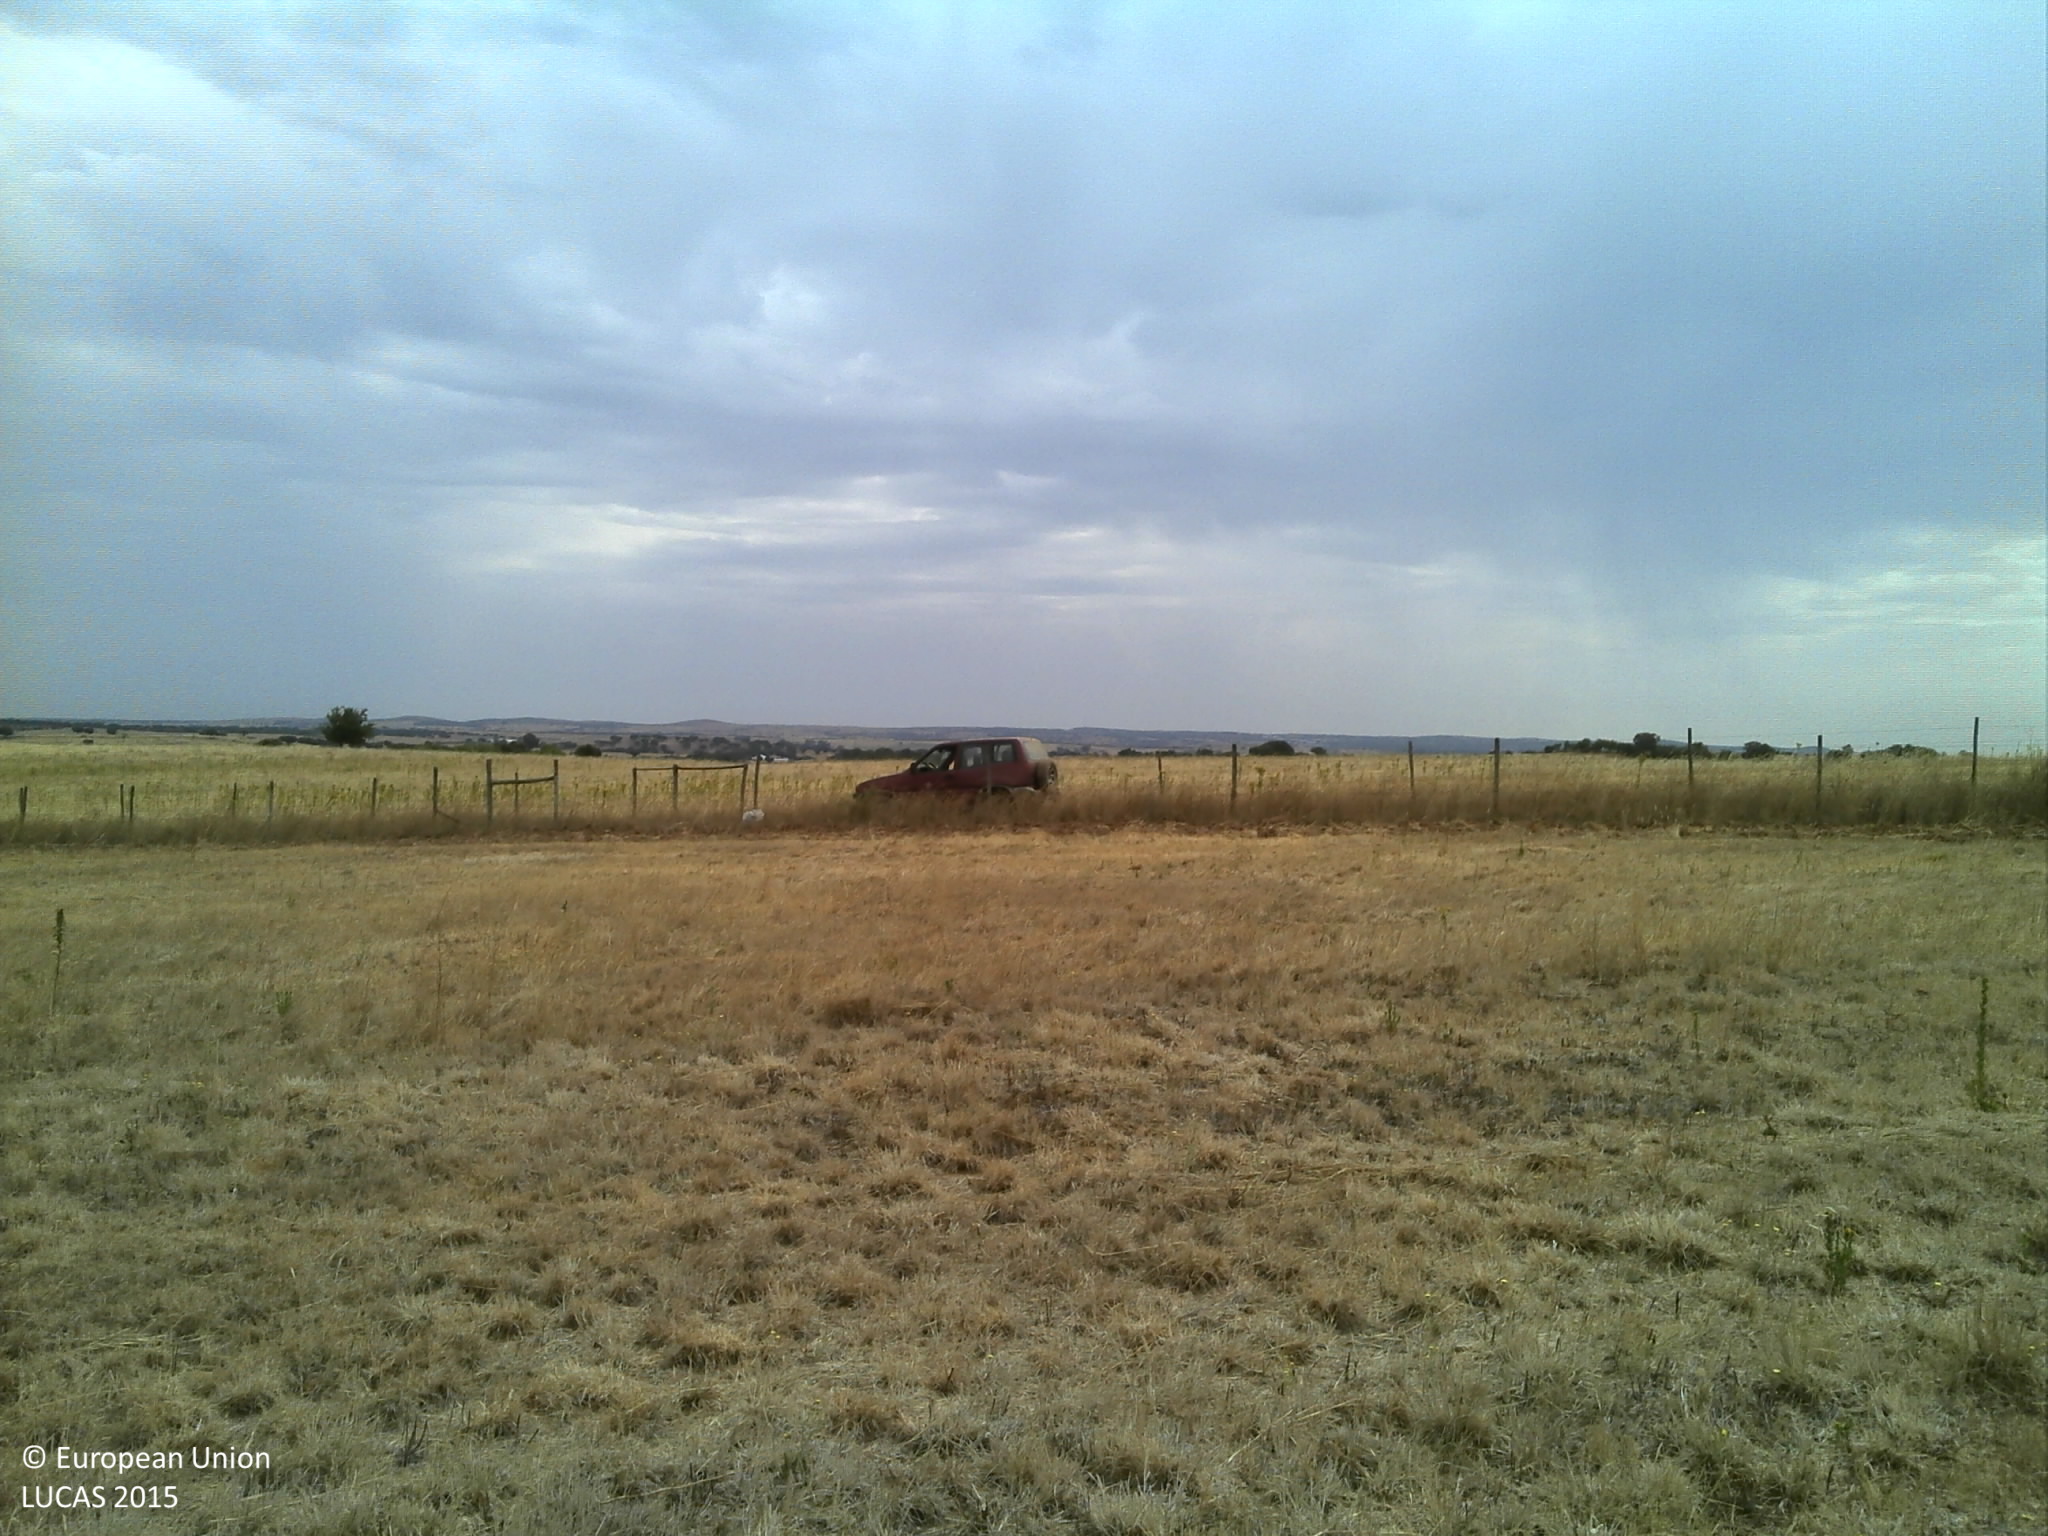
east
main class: Grassland
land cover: Grassland without tree/shrub cover
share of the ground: 25 - 50 %
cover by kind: unconsolidated bare surface 60 %, herbaceous plants 40 %
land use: Agriculture (excluding fallow land and kitchen gardens)
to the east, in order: Grassland without tree/shrub cover; Other bare soil; Grass margins; Fences; Grass margins; Tracks; Grass margins; Fences; Grass margins; Other bare soil; Grassland without tree/shrub cover
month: July
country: PT
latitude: 38.8432
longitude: -7.4187
